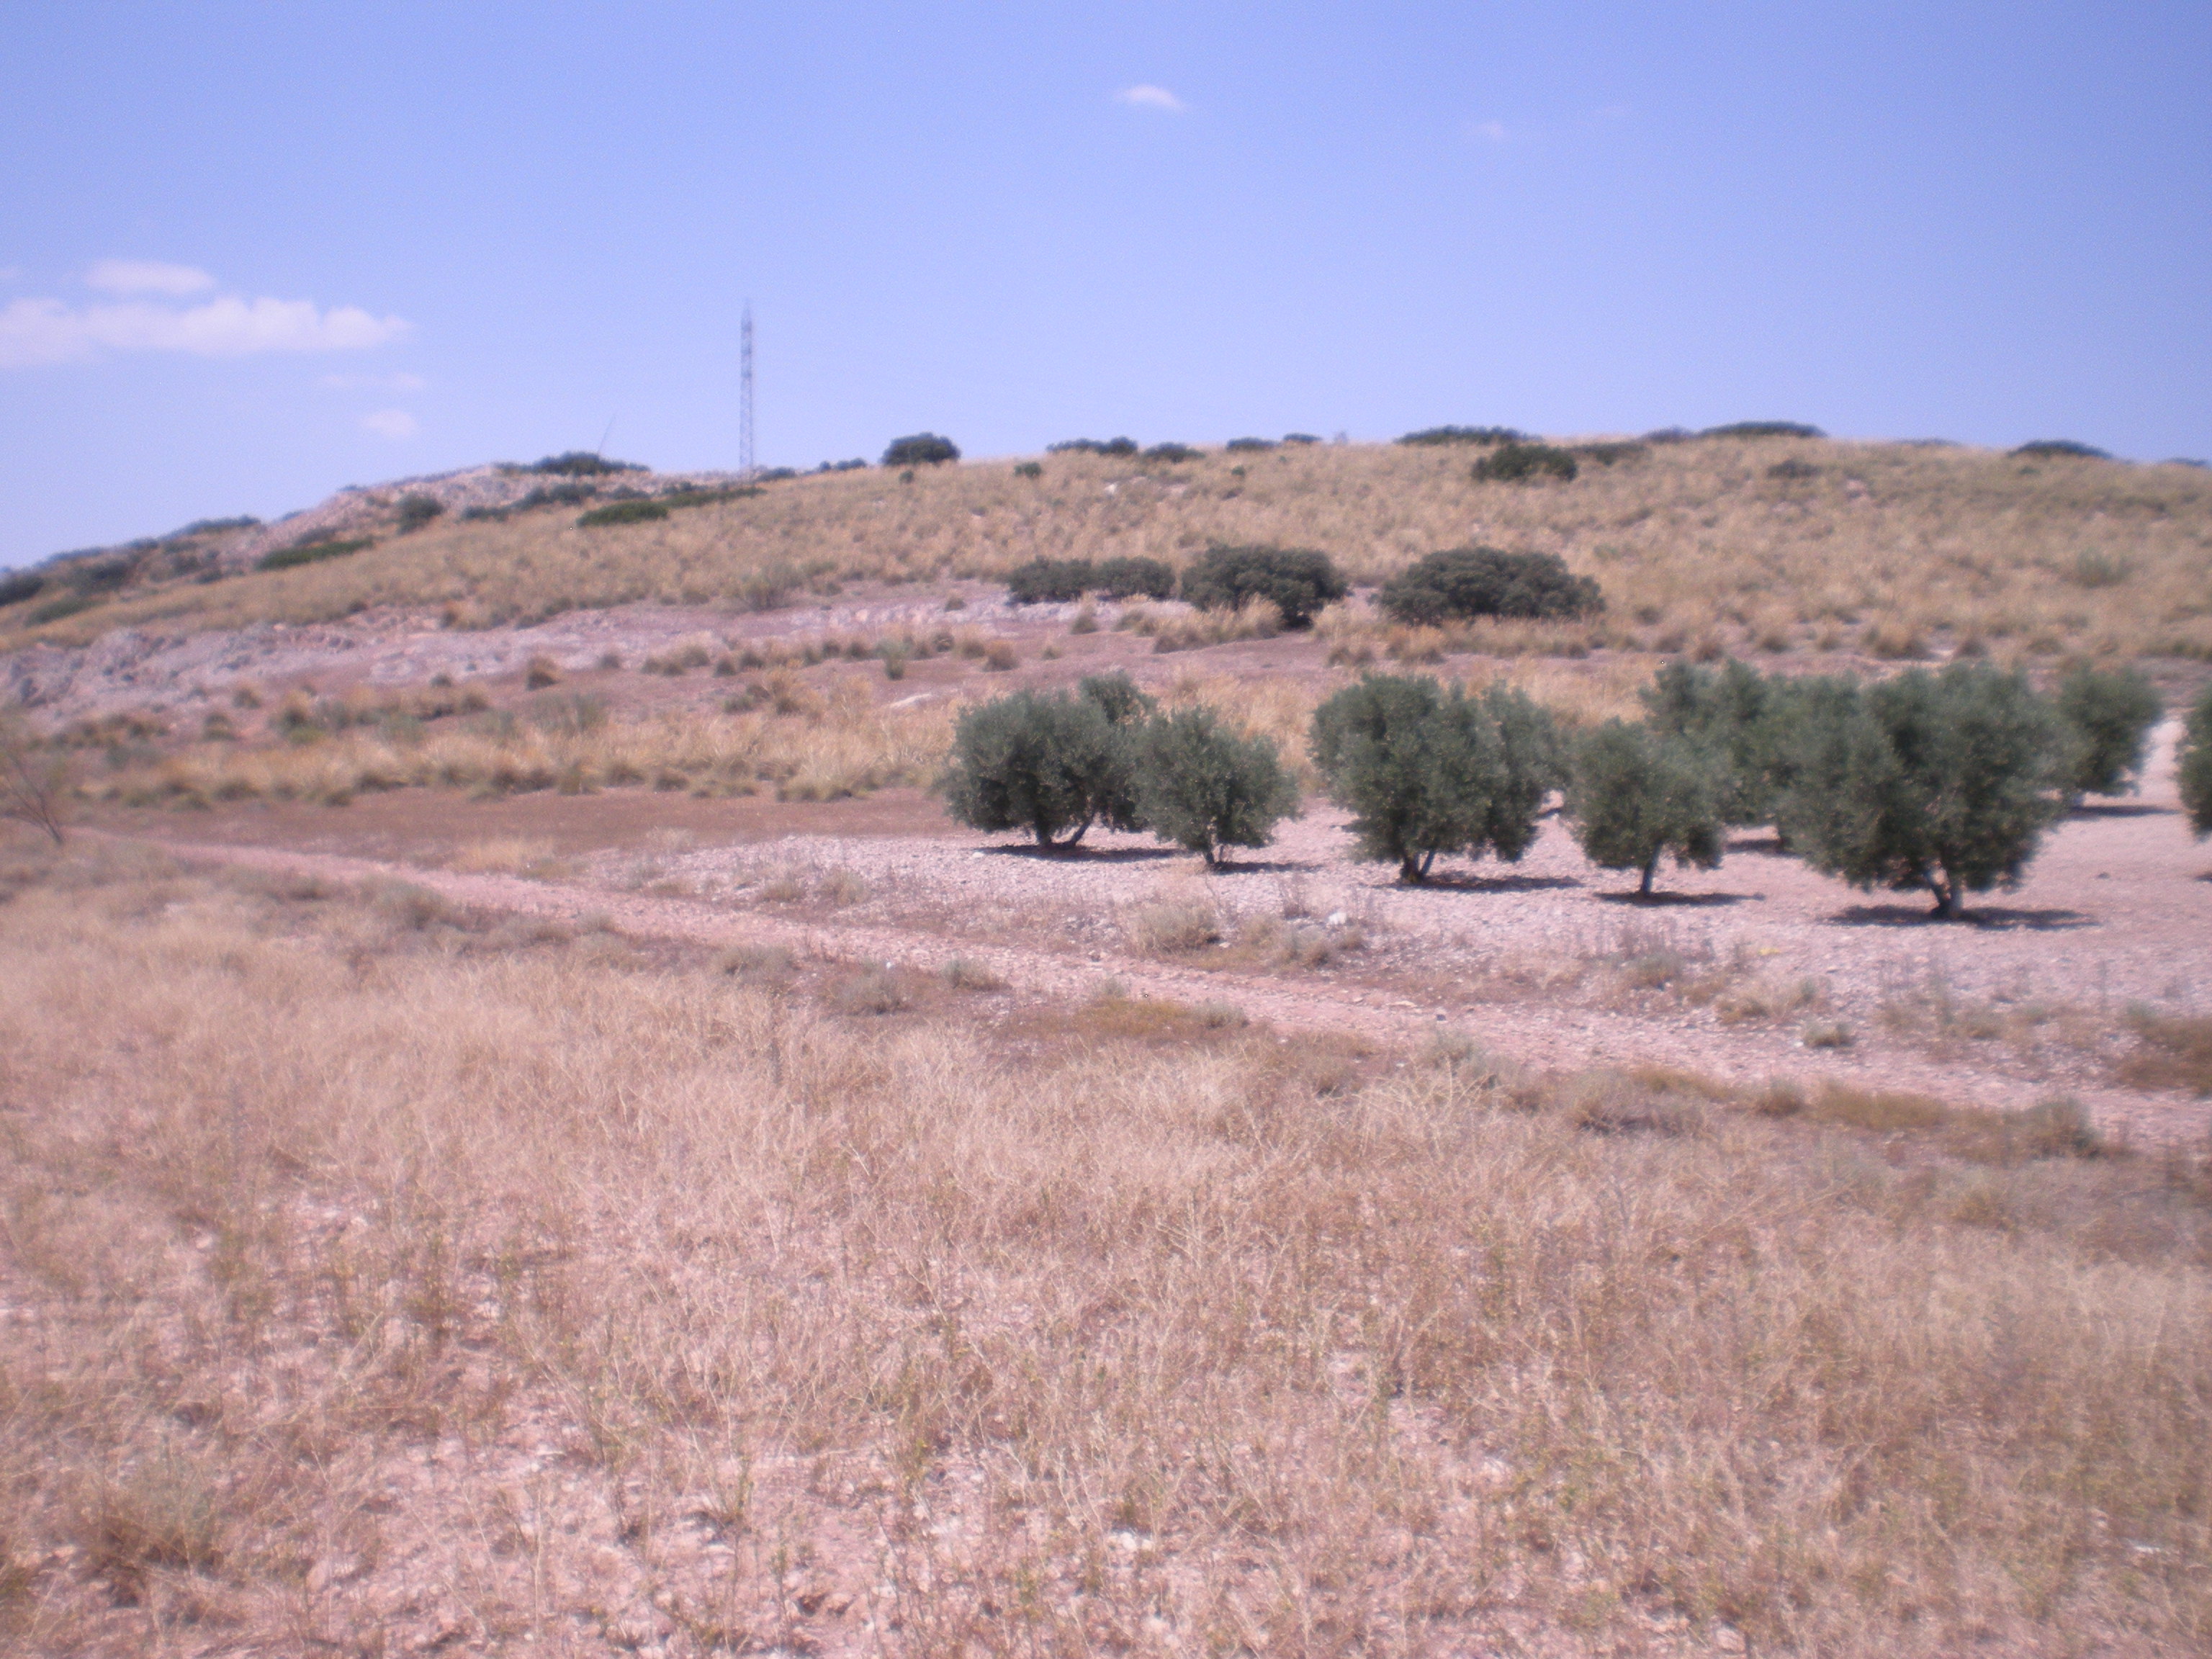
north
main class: Grassland
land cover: Spontaneously vegetated surfaces
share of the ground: 25 - 50 %
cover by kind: unconsolidated bare surface 70 %, herbaceous plants 30 %
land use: Abandoned areas
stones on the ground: < 10 %
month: June
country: ES
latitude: 39.6236
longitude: -3.3615
